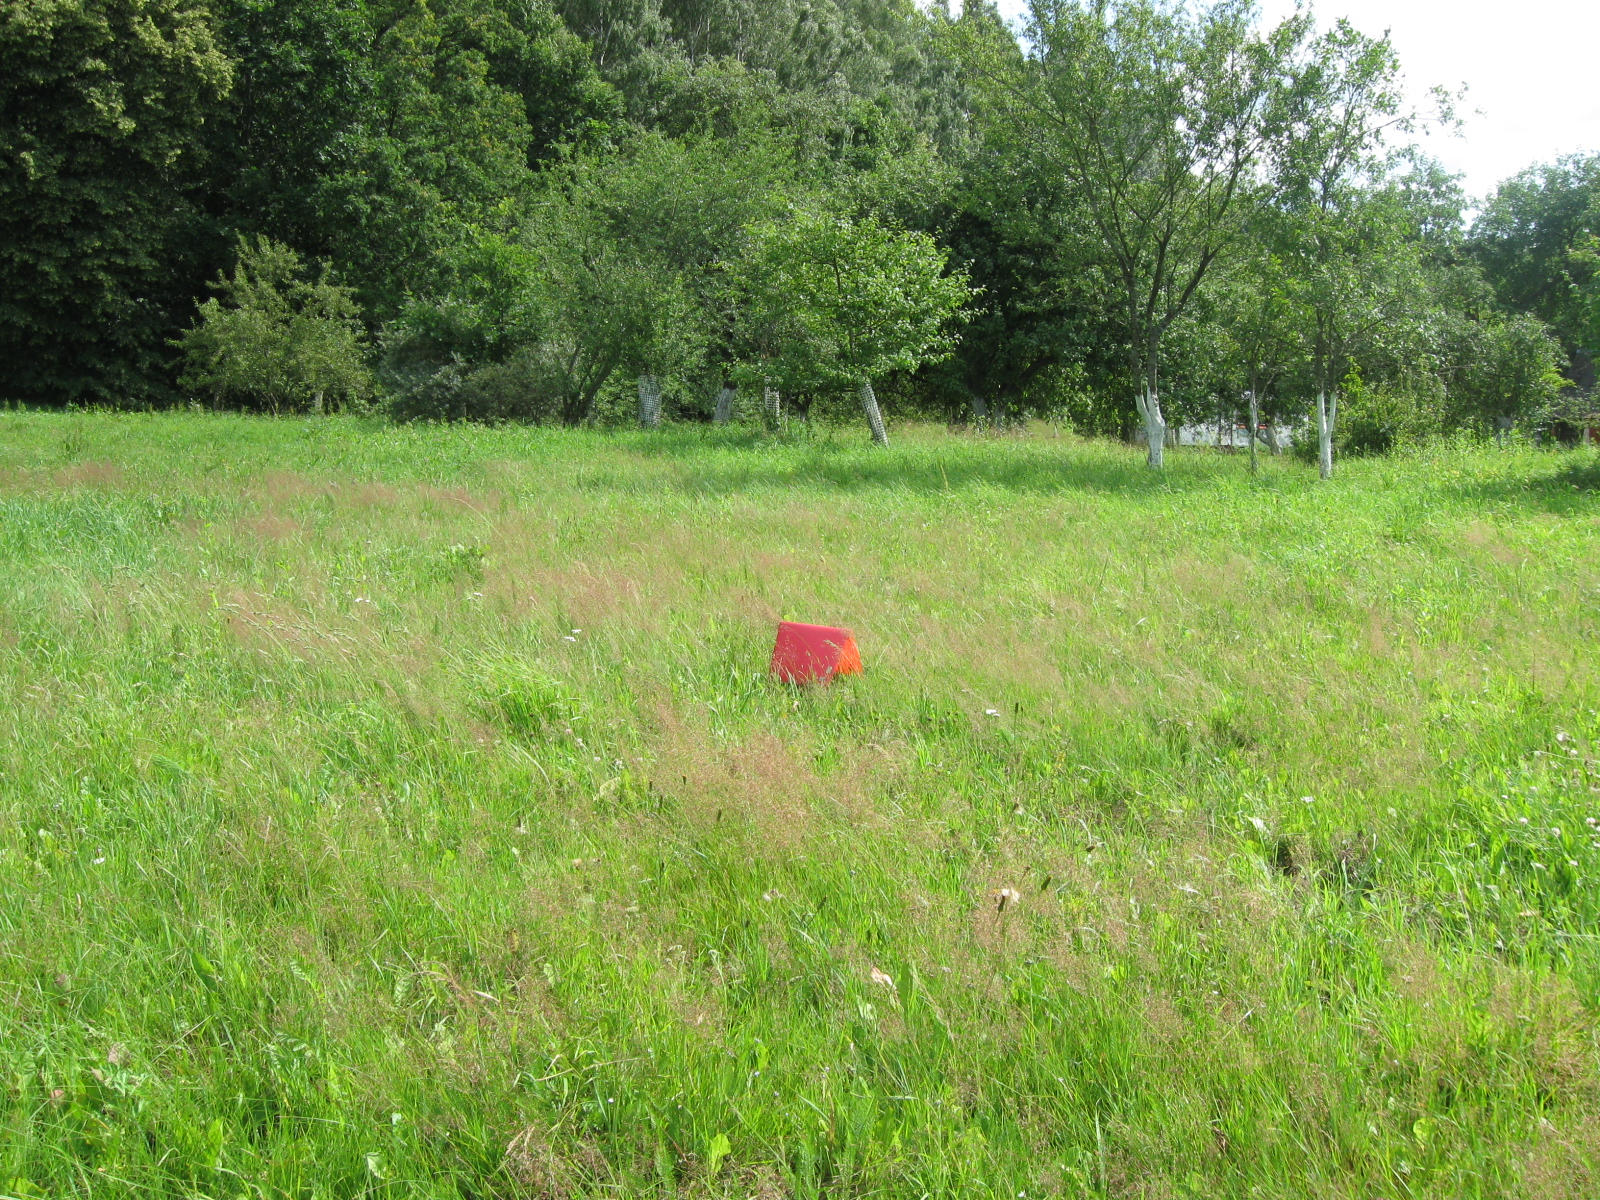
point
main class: Grassland
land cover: Grassland without tree/shrub cover
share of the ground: > 75 %
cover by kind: herbaceous plants 100 %
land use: Agriculture (excluding fallow land and kitchen gardens)
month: July
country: LT
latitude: 55.0925
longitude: 23.4450
